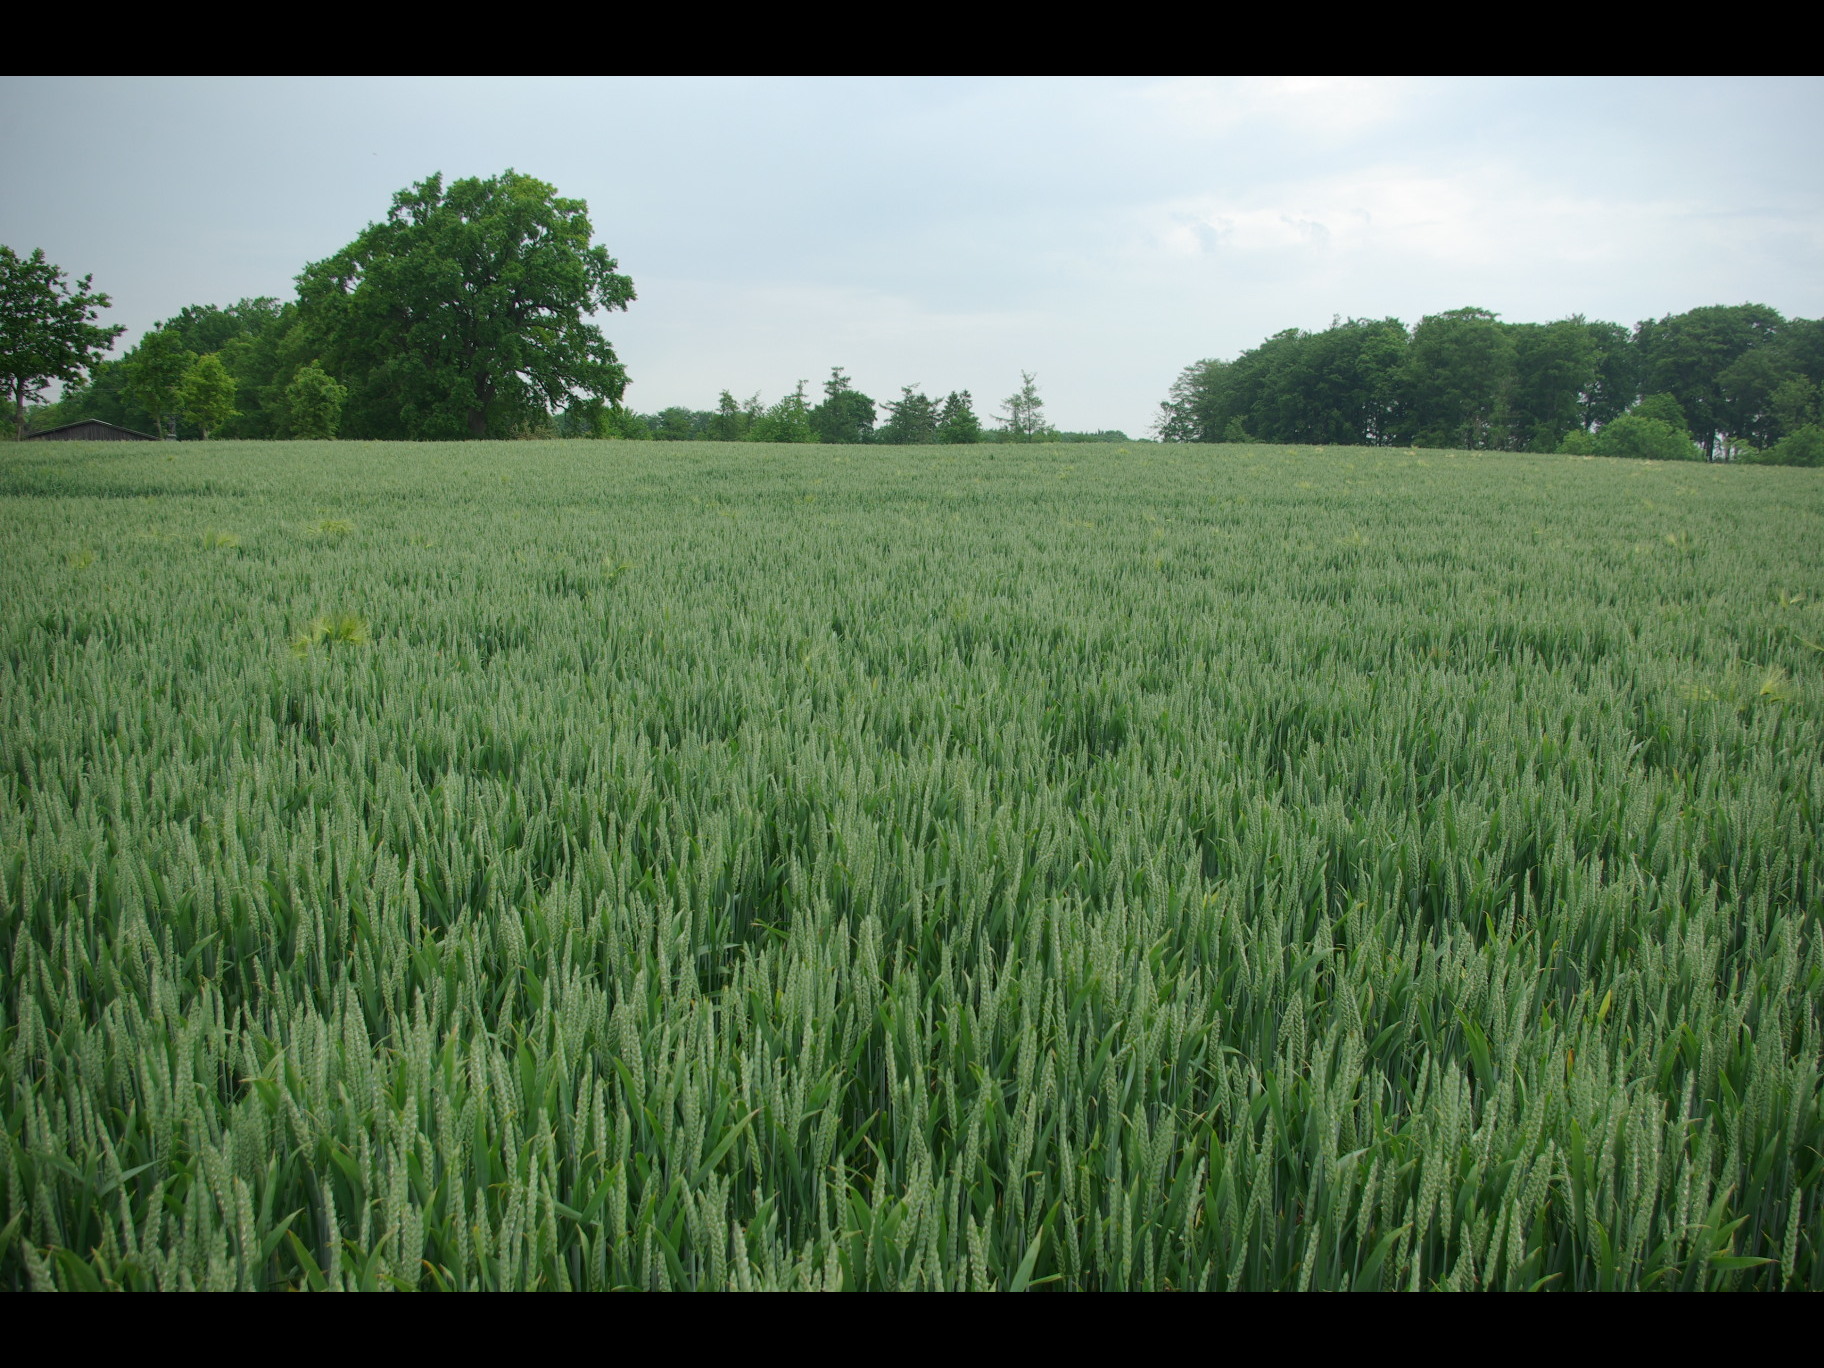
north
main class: Cropland
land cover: Common wheat
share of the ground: > 75 %
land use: Agriculture (excluding fallow land and kitchen gardens)
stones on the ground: 10 - 25 %
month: June
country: DE
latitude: 54.4443
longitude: 9.9538
